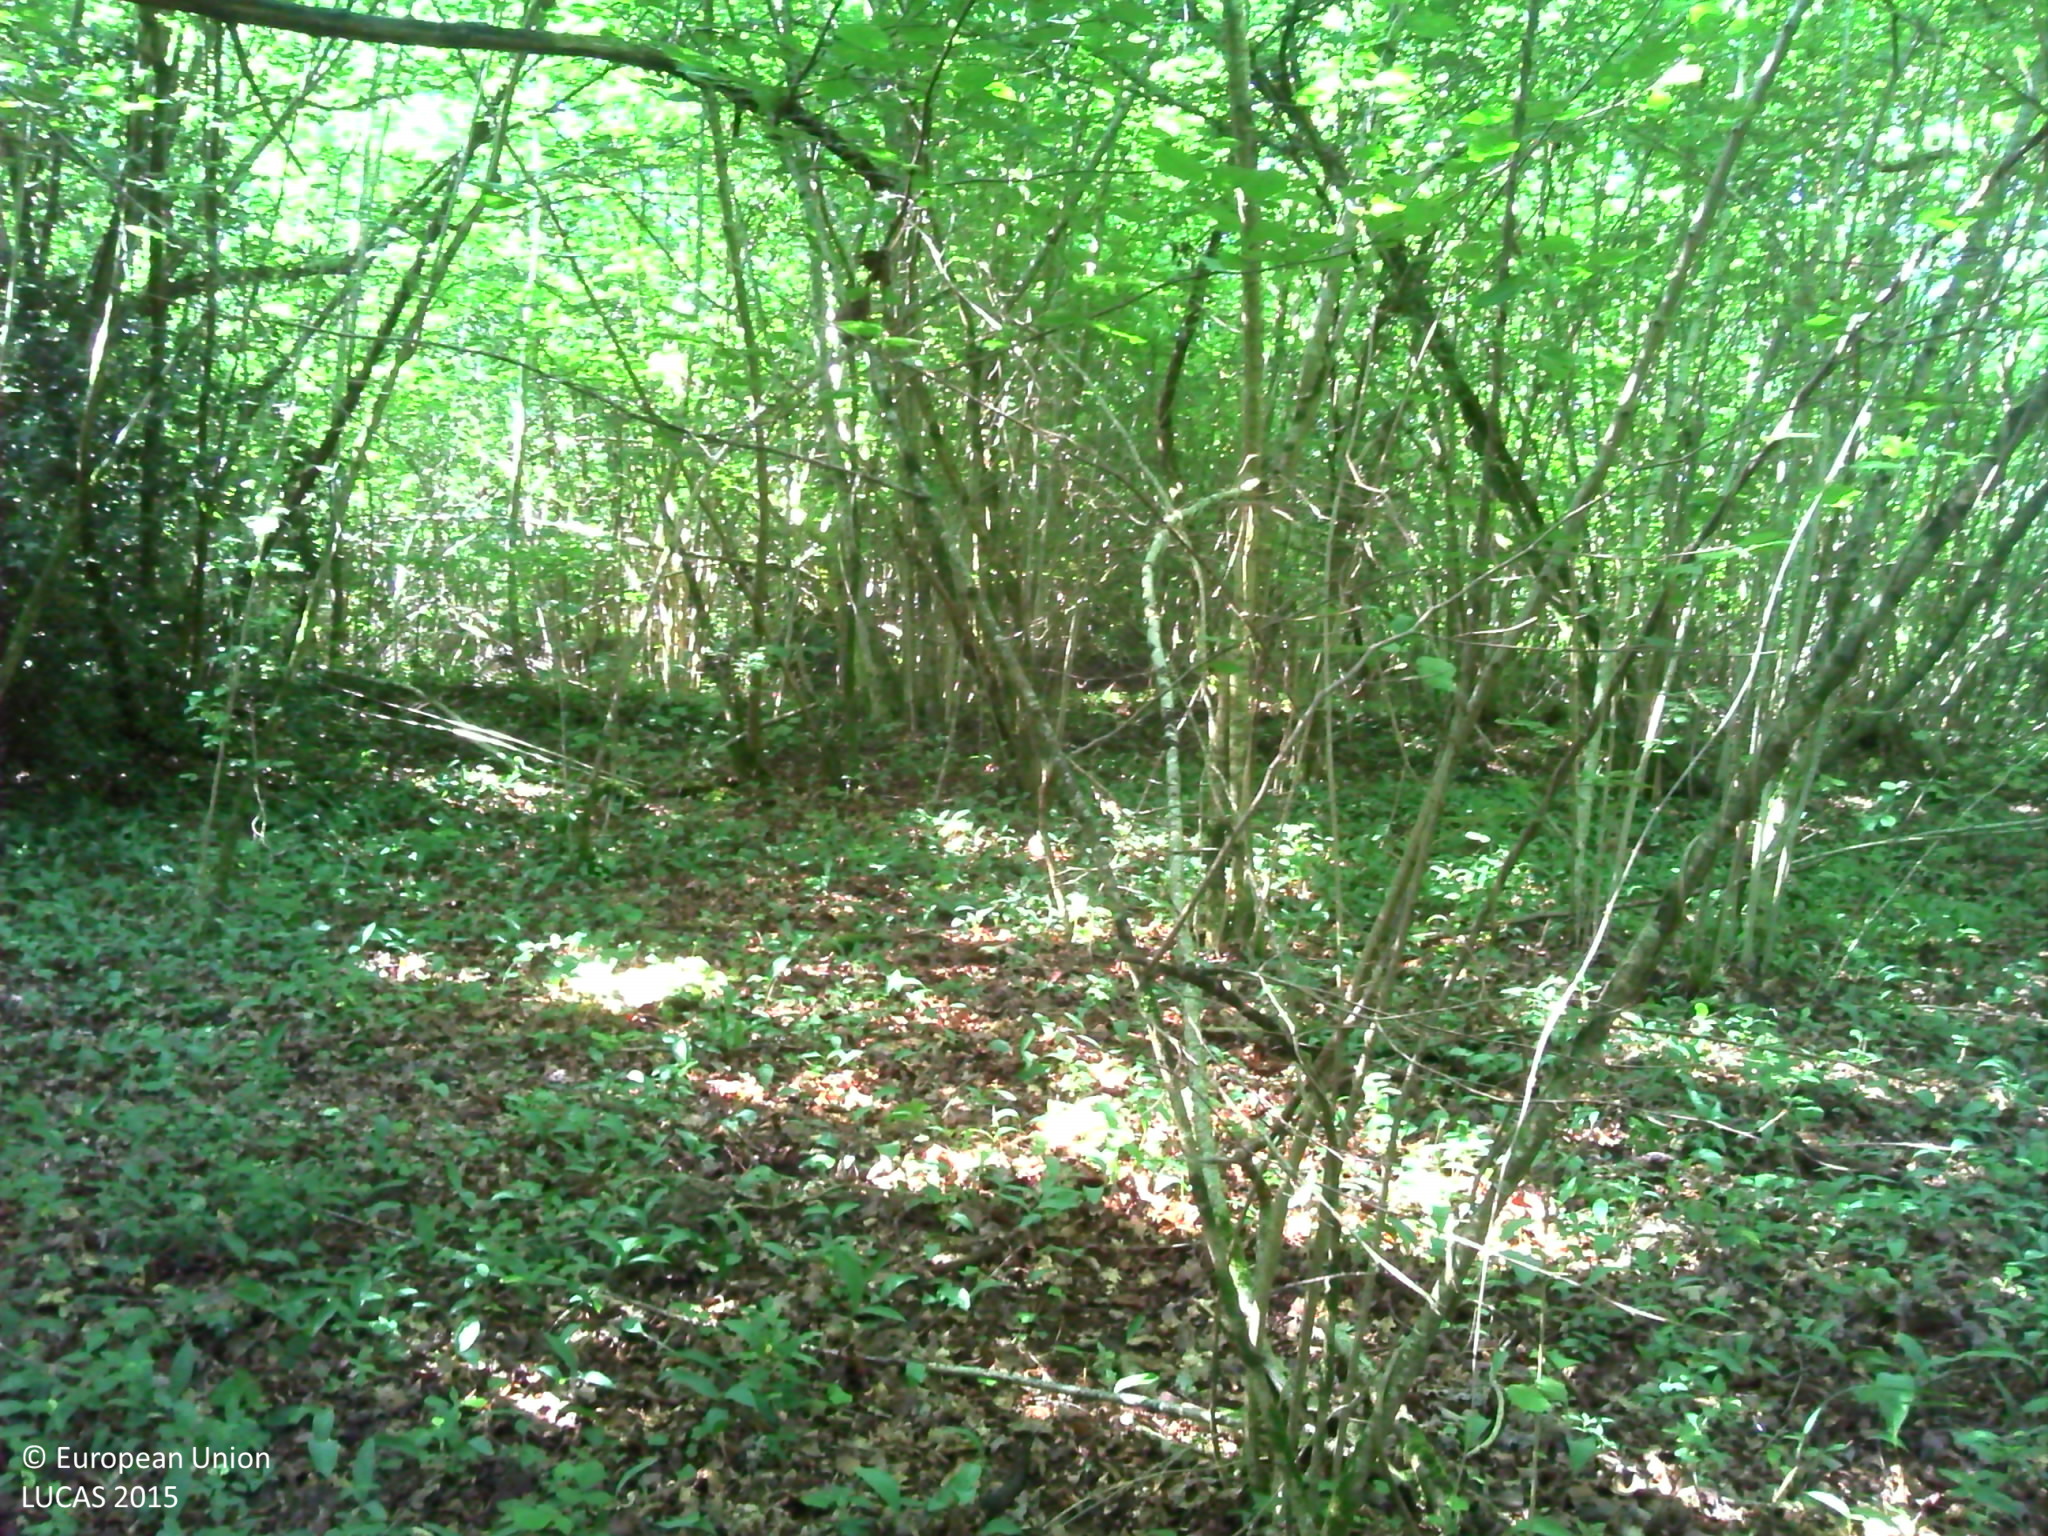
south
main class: Woodland
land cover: Broadleaved woodland
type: mesophytic deciduous forest
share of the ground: > 75 %
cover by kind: broadleaved forest trees 90 %, shrubs 5 %, lichens and mosses 5 %
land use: Forestry
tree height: > 5 m
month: June
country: FR
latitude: 46.9182
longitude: 5.3664
